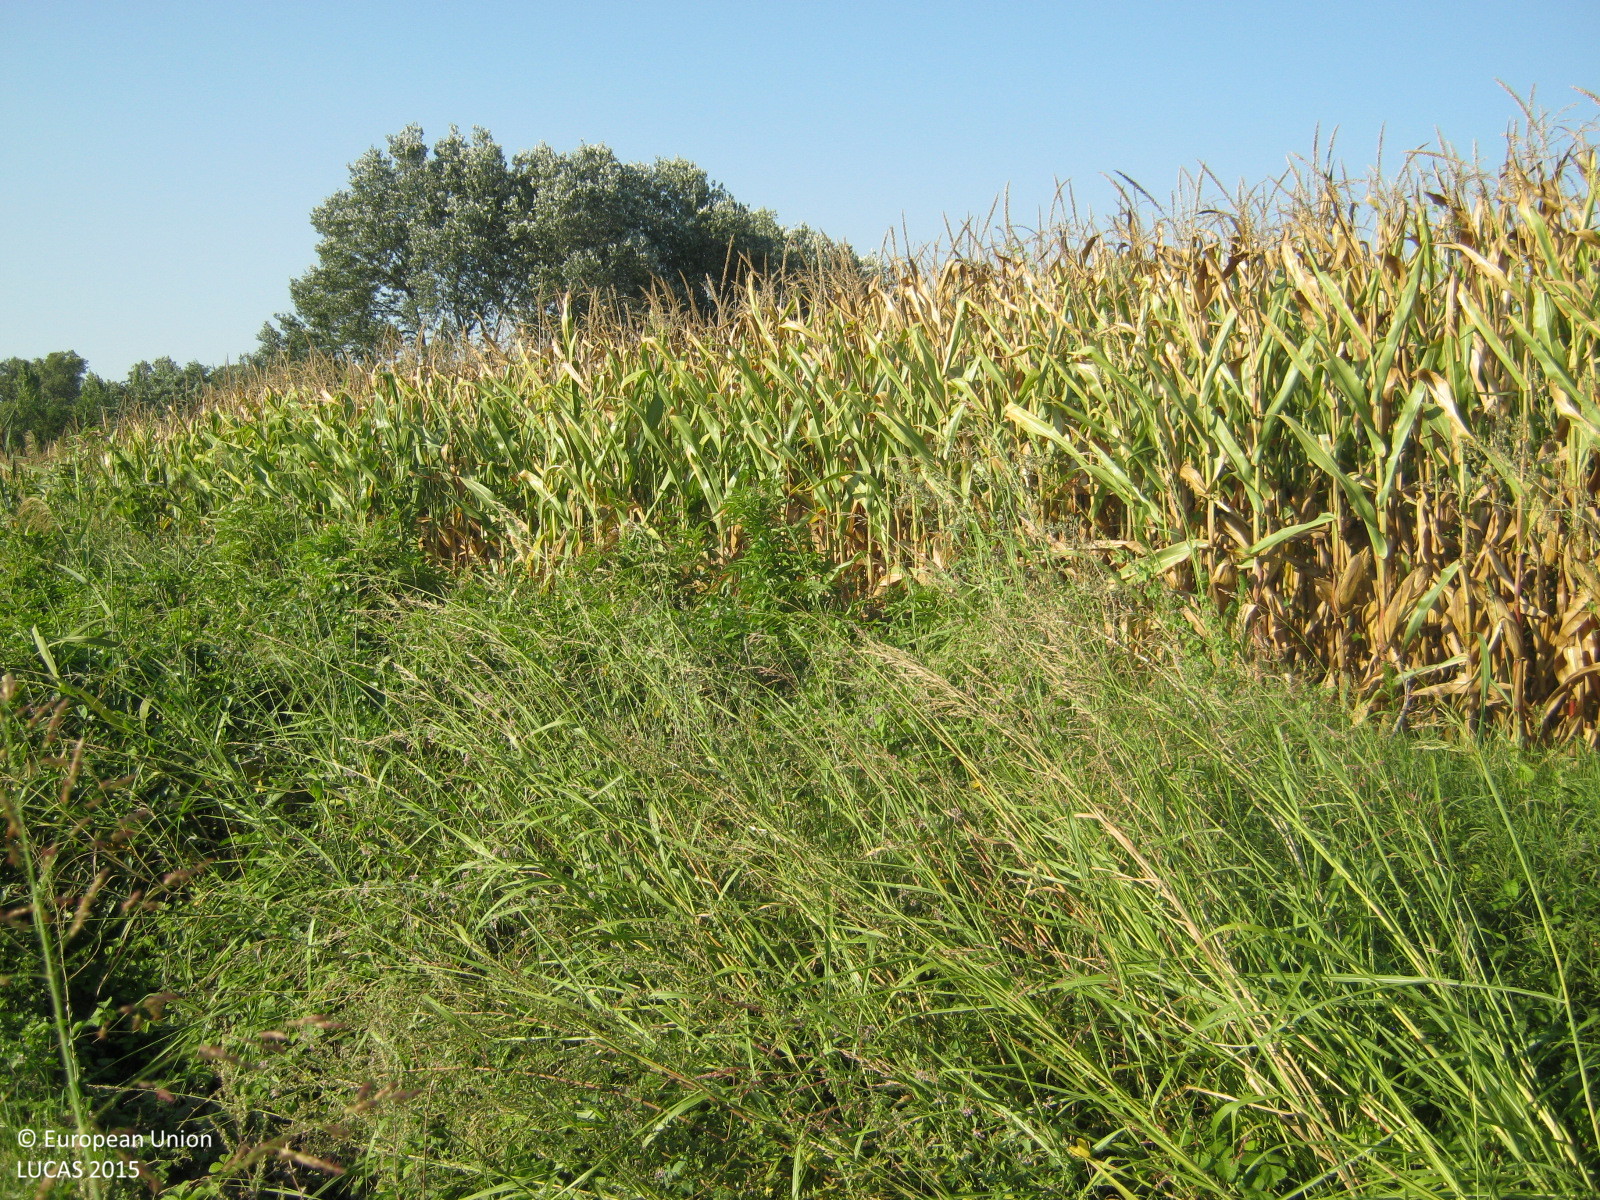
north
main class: Cropland
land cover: Maize
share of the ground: > 75 %
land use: Agriculture (excluding fallow land and kitchen gardens)
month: August
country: GR
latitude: 41.3636
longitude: 23.3497
